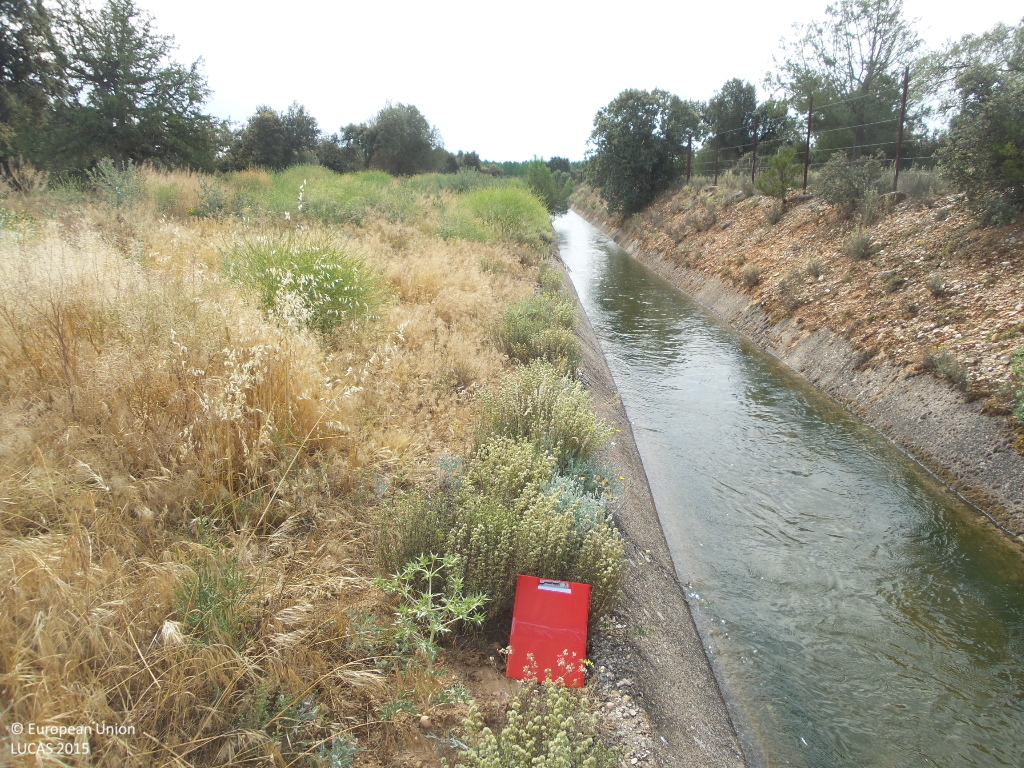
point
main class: Woodland
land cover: Broadleaved woodland
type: broadleaved evergreen forest
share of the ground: 10 - 25 %
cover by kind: herbaceous plants 40 %, shrubs 25 %, broadleaved forest trees 20 %, unconsolidated bare surface 10 %, coniferous forest trees 5 %
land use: Forestry
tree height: > 5 m
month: June
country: ES
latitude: 41.5258
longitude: -3.0938
